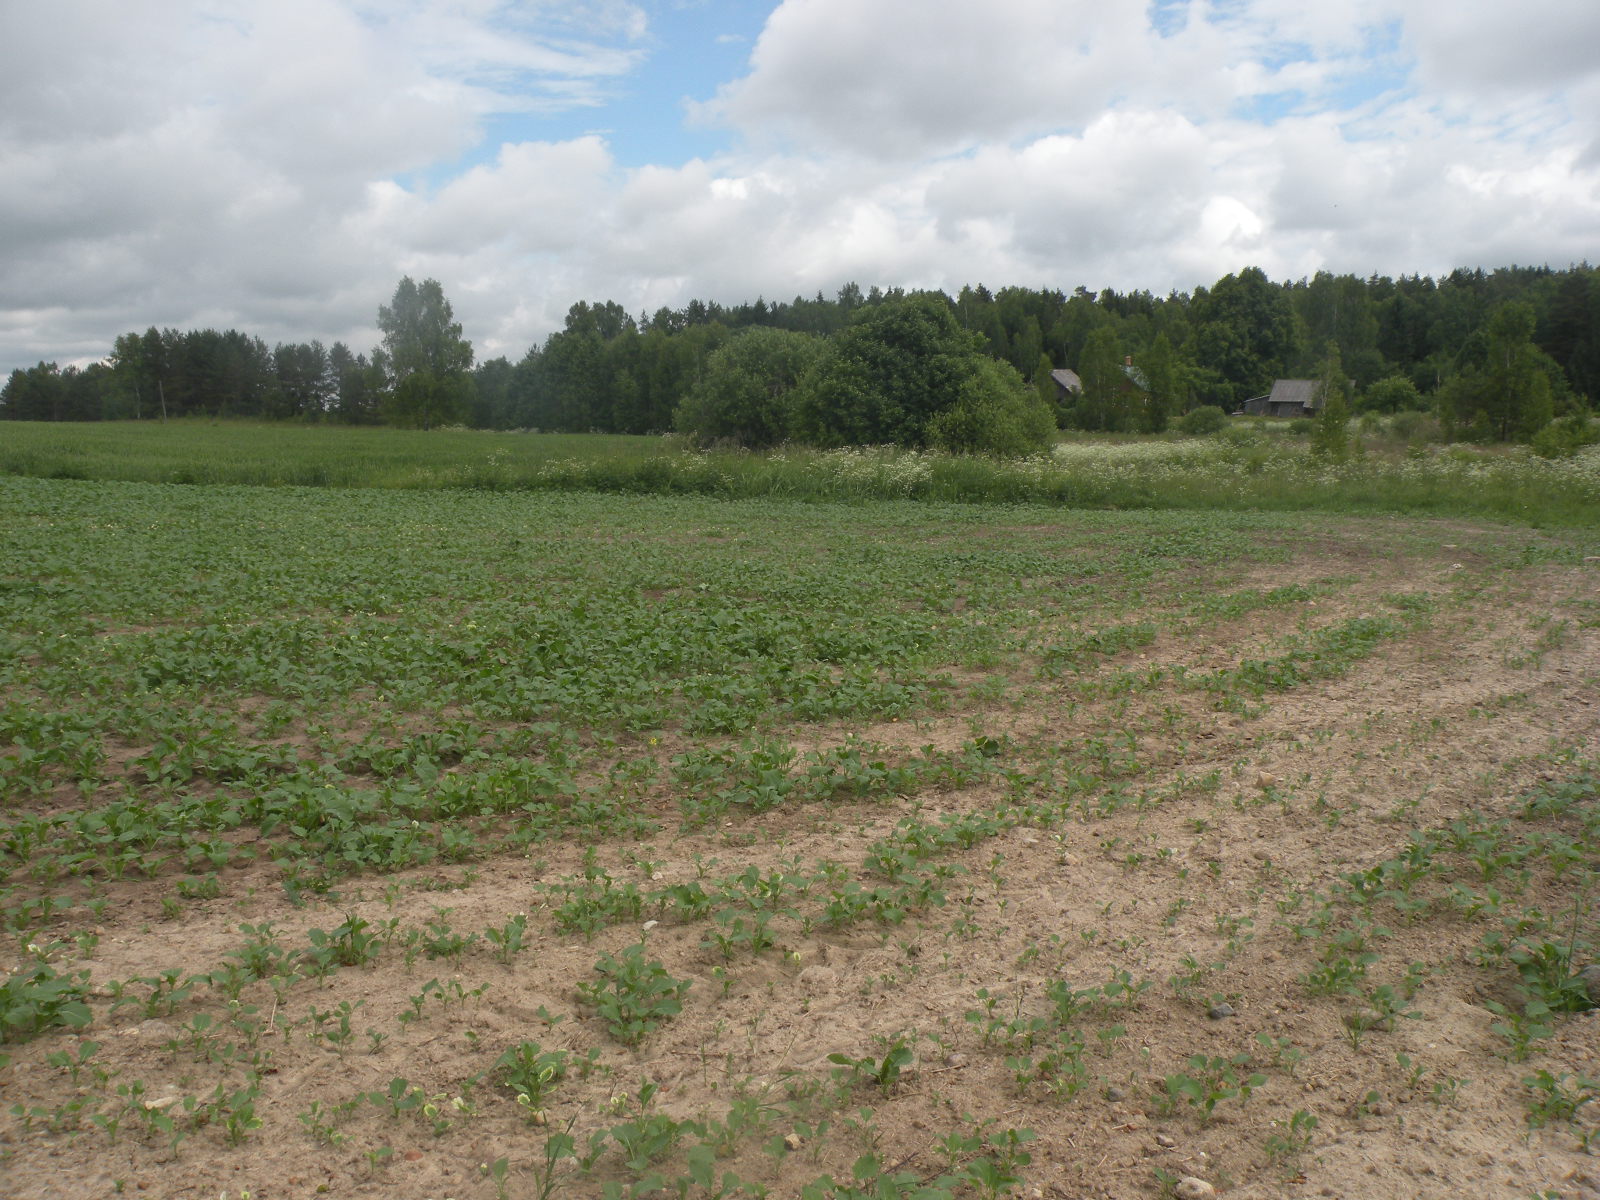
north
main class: Cropland
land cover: Rape and turnip rape
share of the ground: 10 - 25 %
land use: Agriculture (excluding fallow land and kitchen gardens)
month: June
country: LV
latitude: 55.9401
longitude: 27.0249
